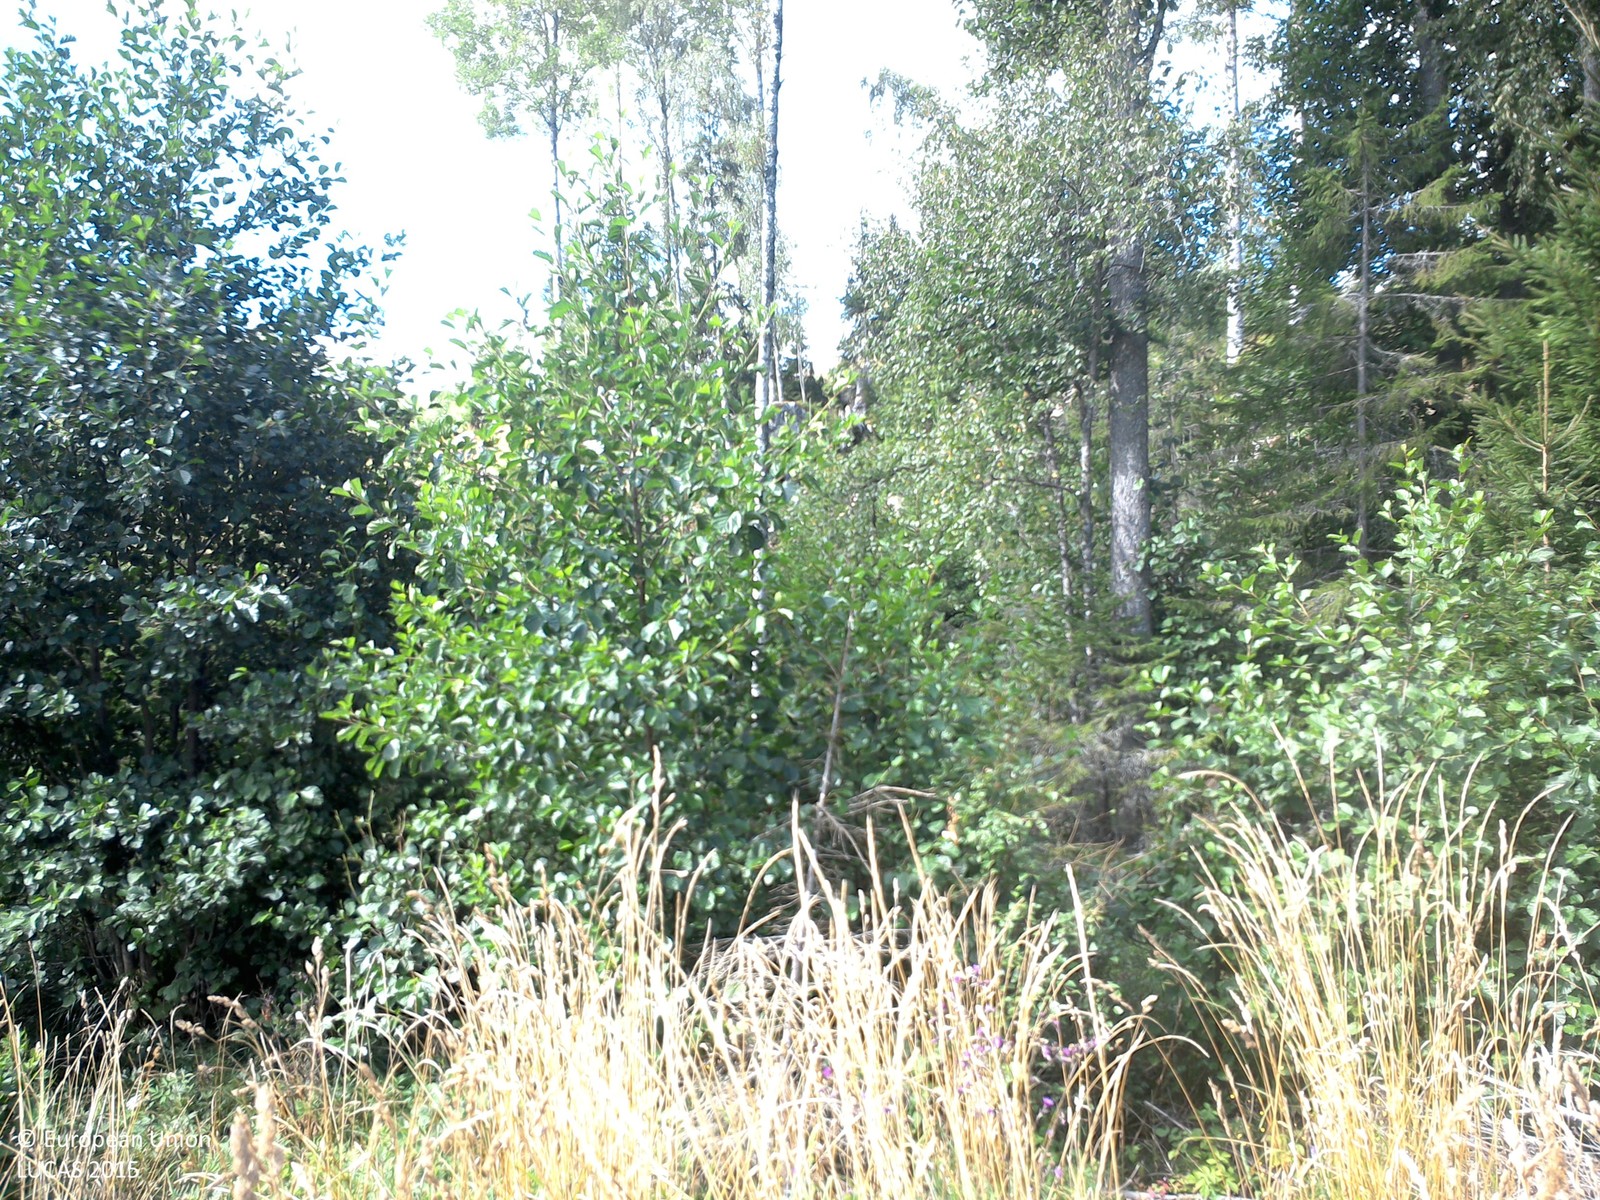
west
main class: Grassland
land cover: Grassland without tree/shrub cover
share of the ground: > 75 %
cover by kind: herbaceous plants 100 %
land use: Semi-natural and natural areas not in use
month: August
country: SE
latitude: 58.0762
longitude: 15.3700
